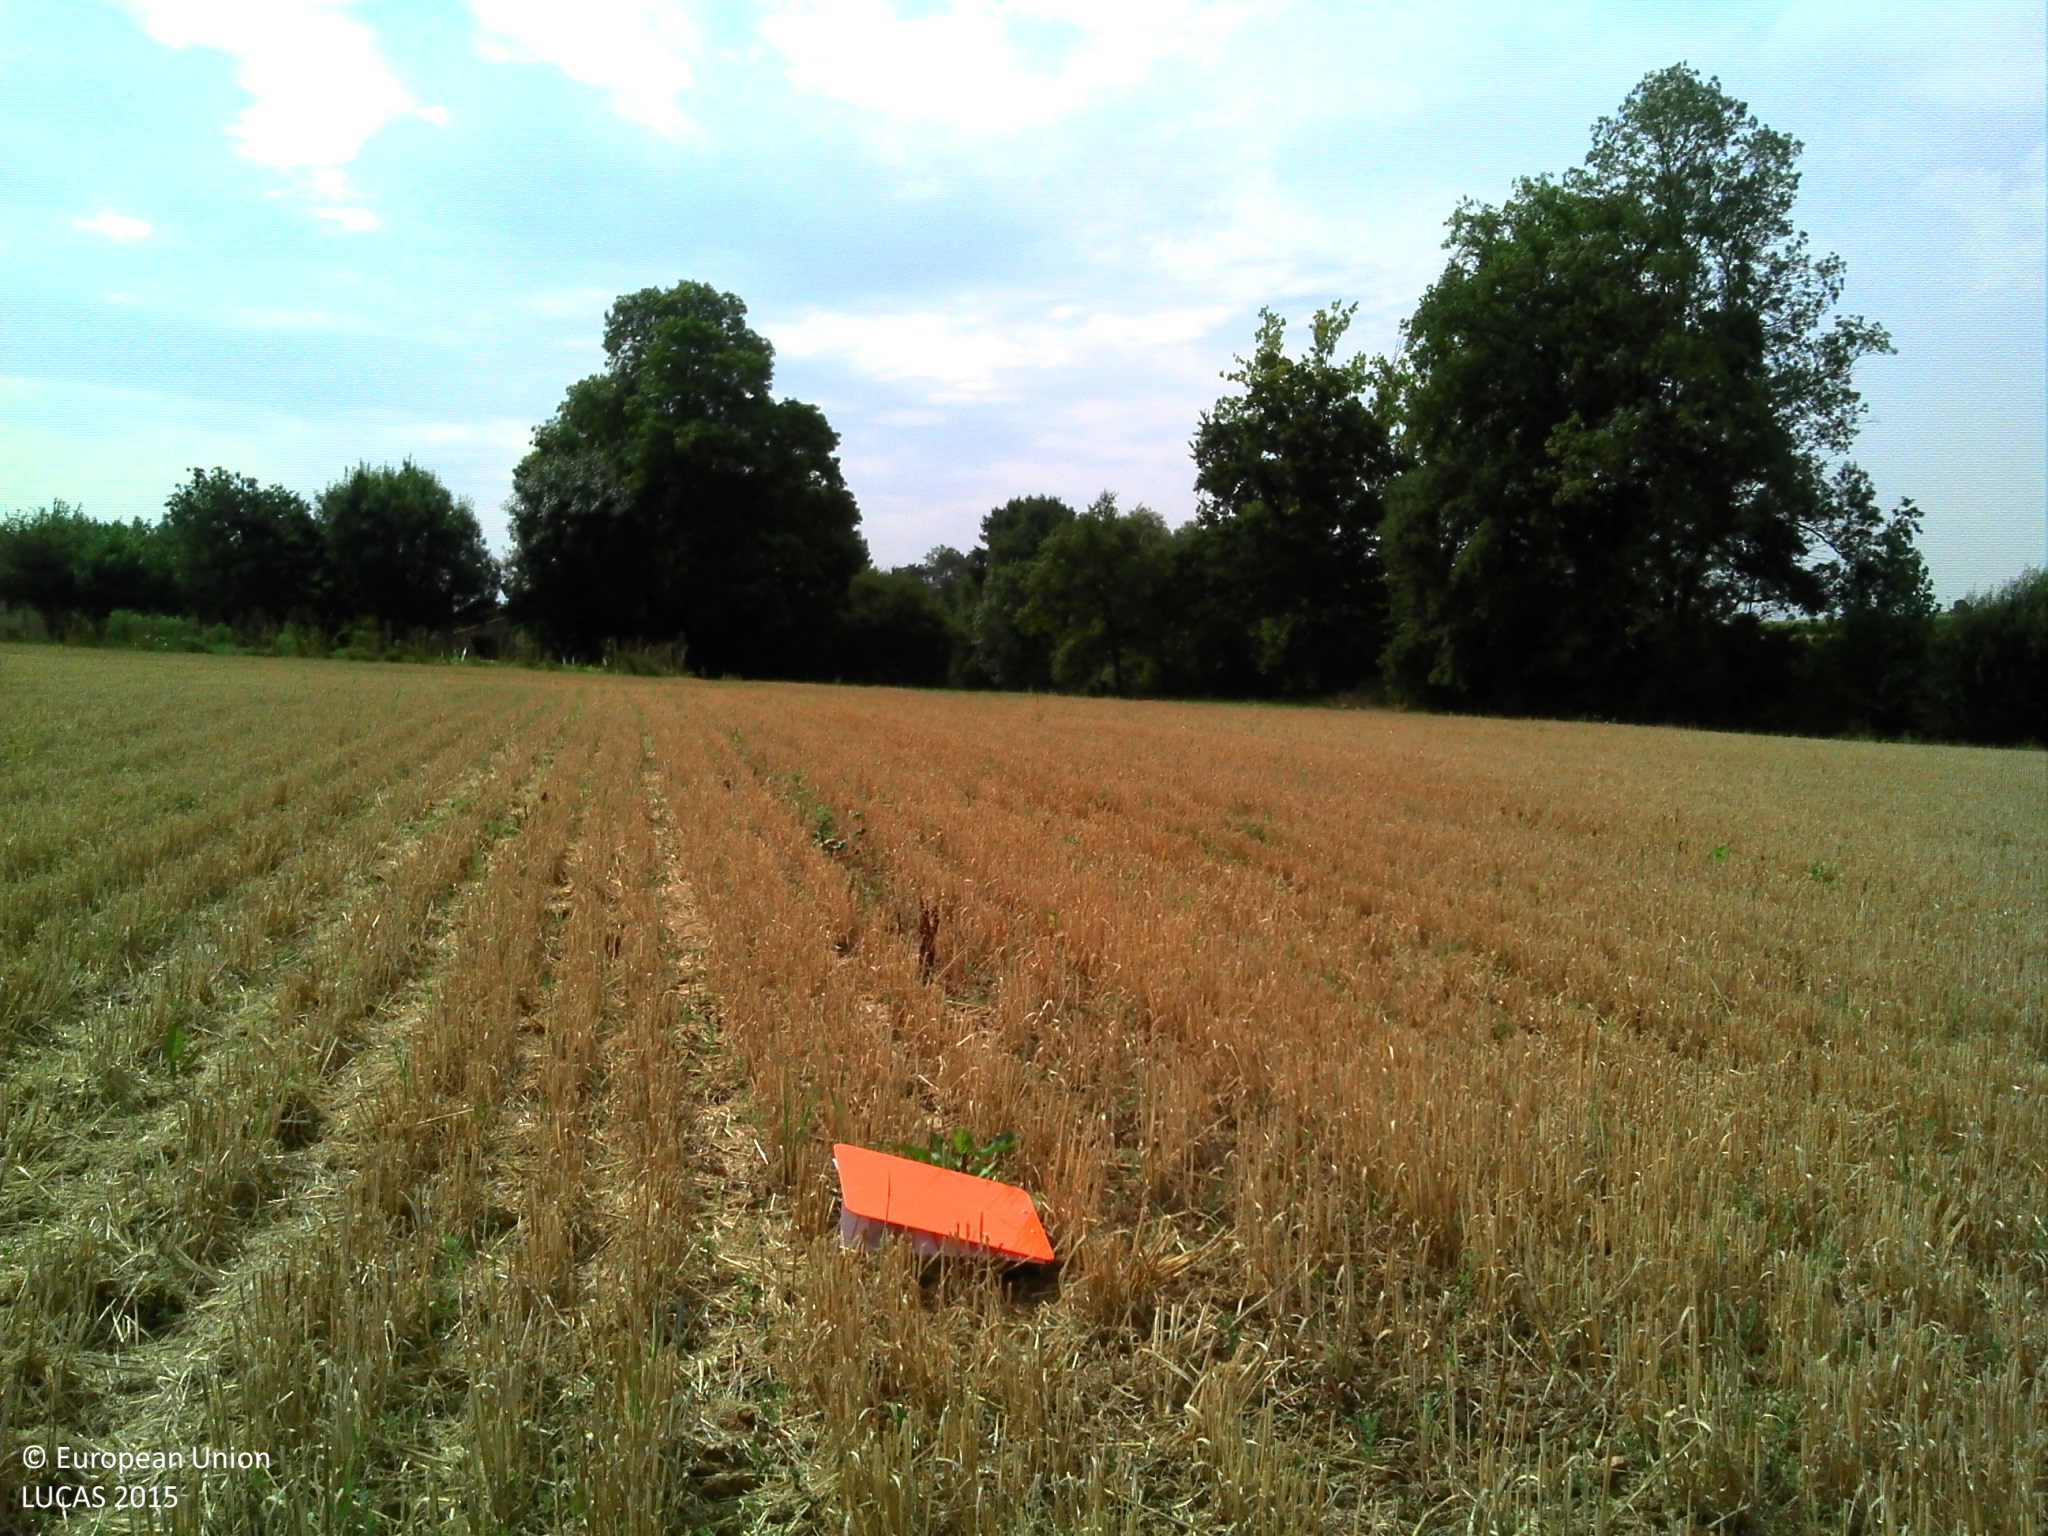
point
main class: Cropland
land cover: Barley
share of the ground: > 75 %
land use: Agriculture (excluding fallow land and kitchen gardens)
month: August
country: FR
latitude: 46.9515
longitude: -1.4576
